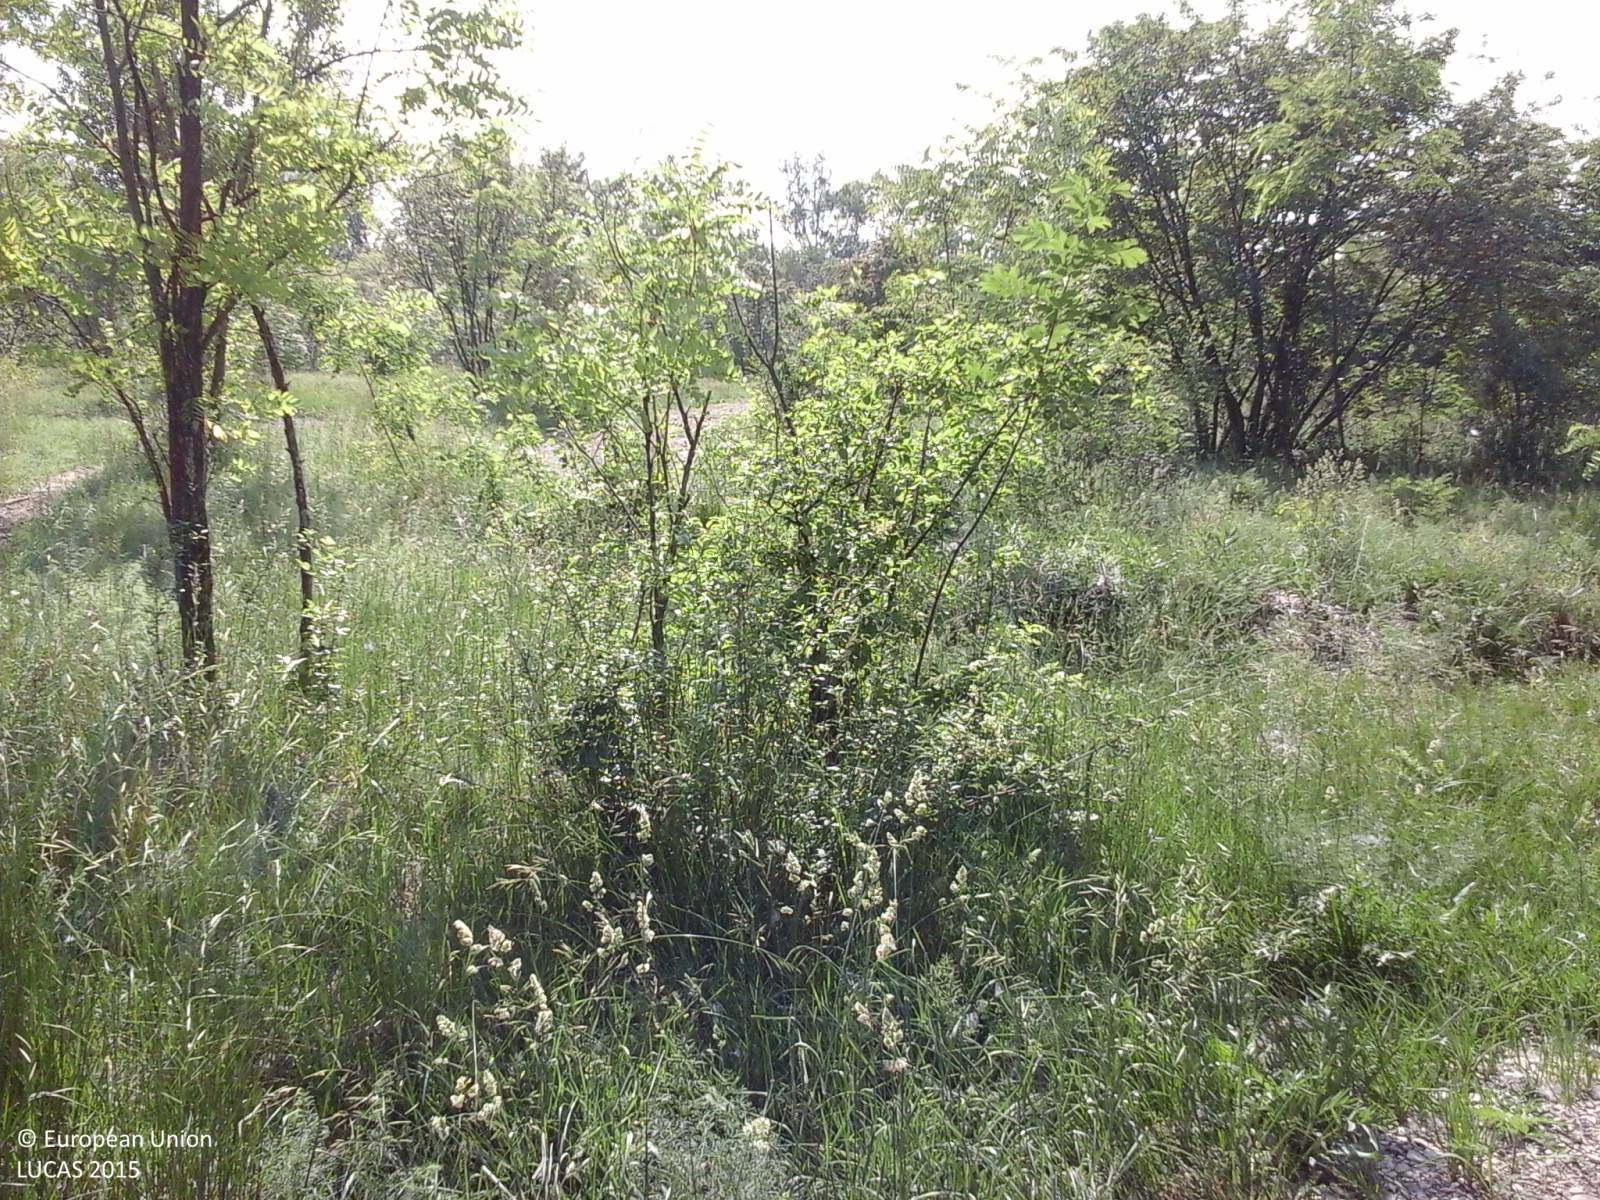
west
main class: Woodland
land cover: Broadleaved woodland
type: mesophytic deciduous forest
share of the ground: > 75 %
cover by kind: broadleaved forest trees 85 %, shrubs 10 %, herbaceous plants 5 %
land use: Forestry
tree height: > 5 m
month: May
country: IT
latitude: 46.0114
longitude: 13.3155
